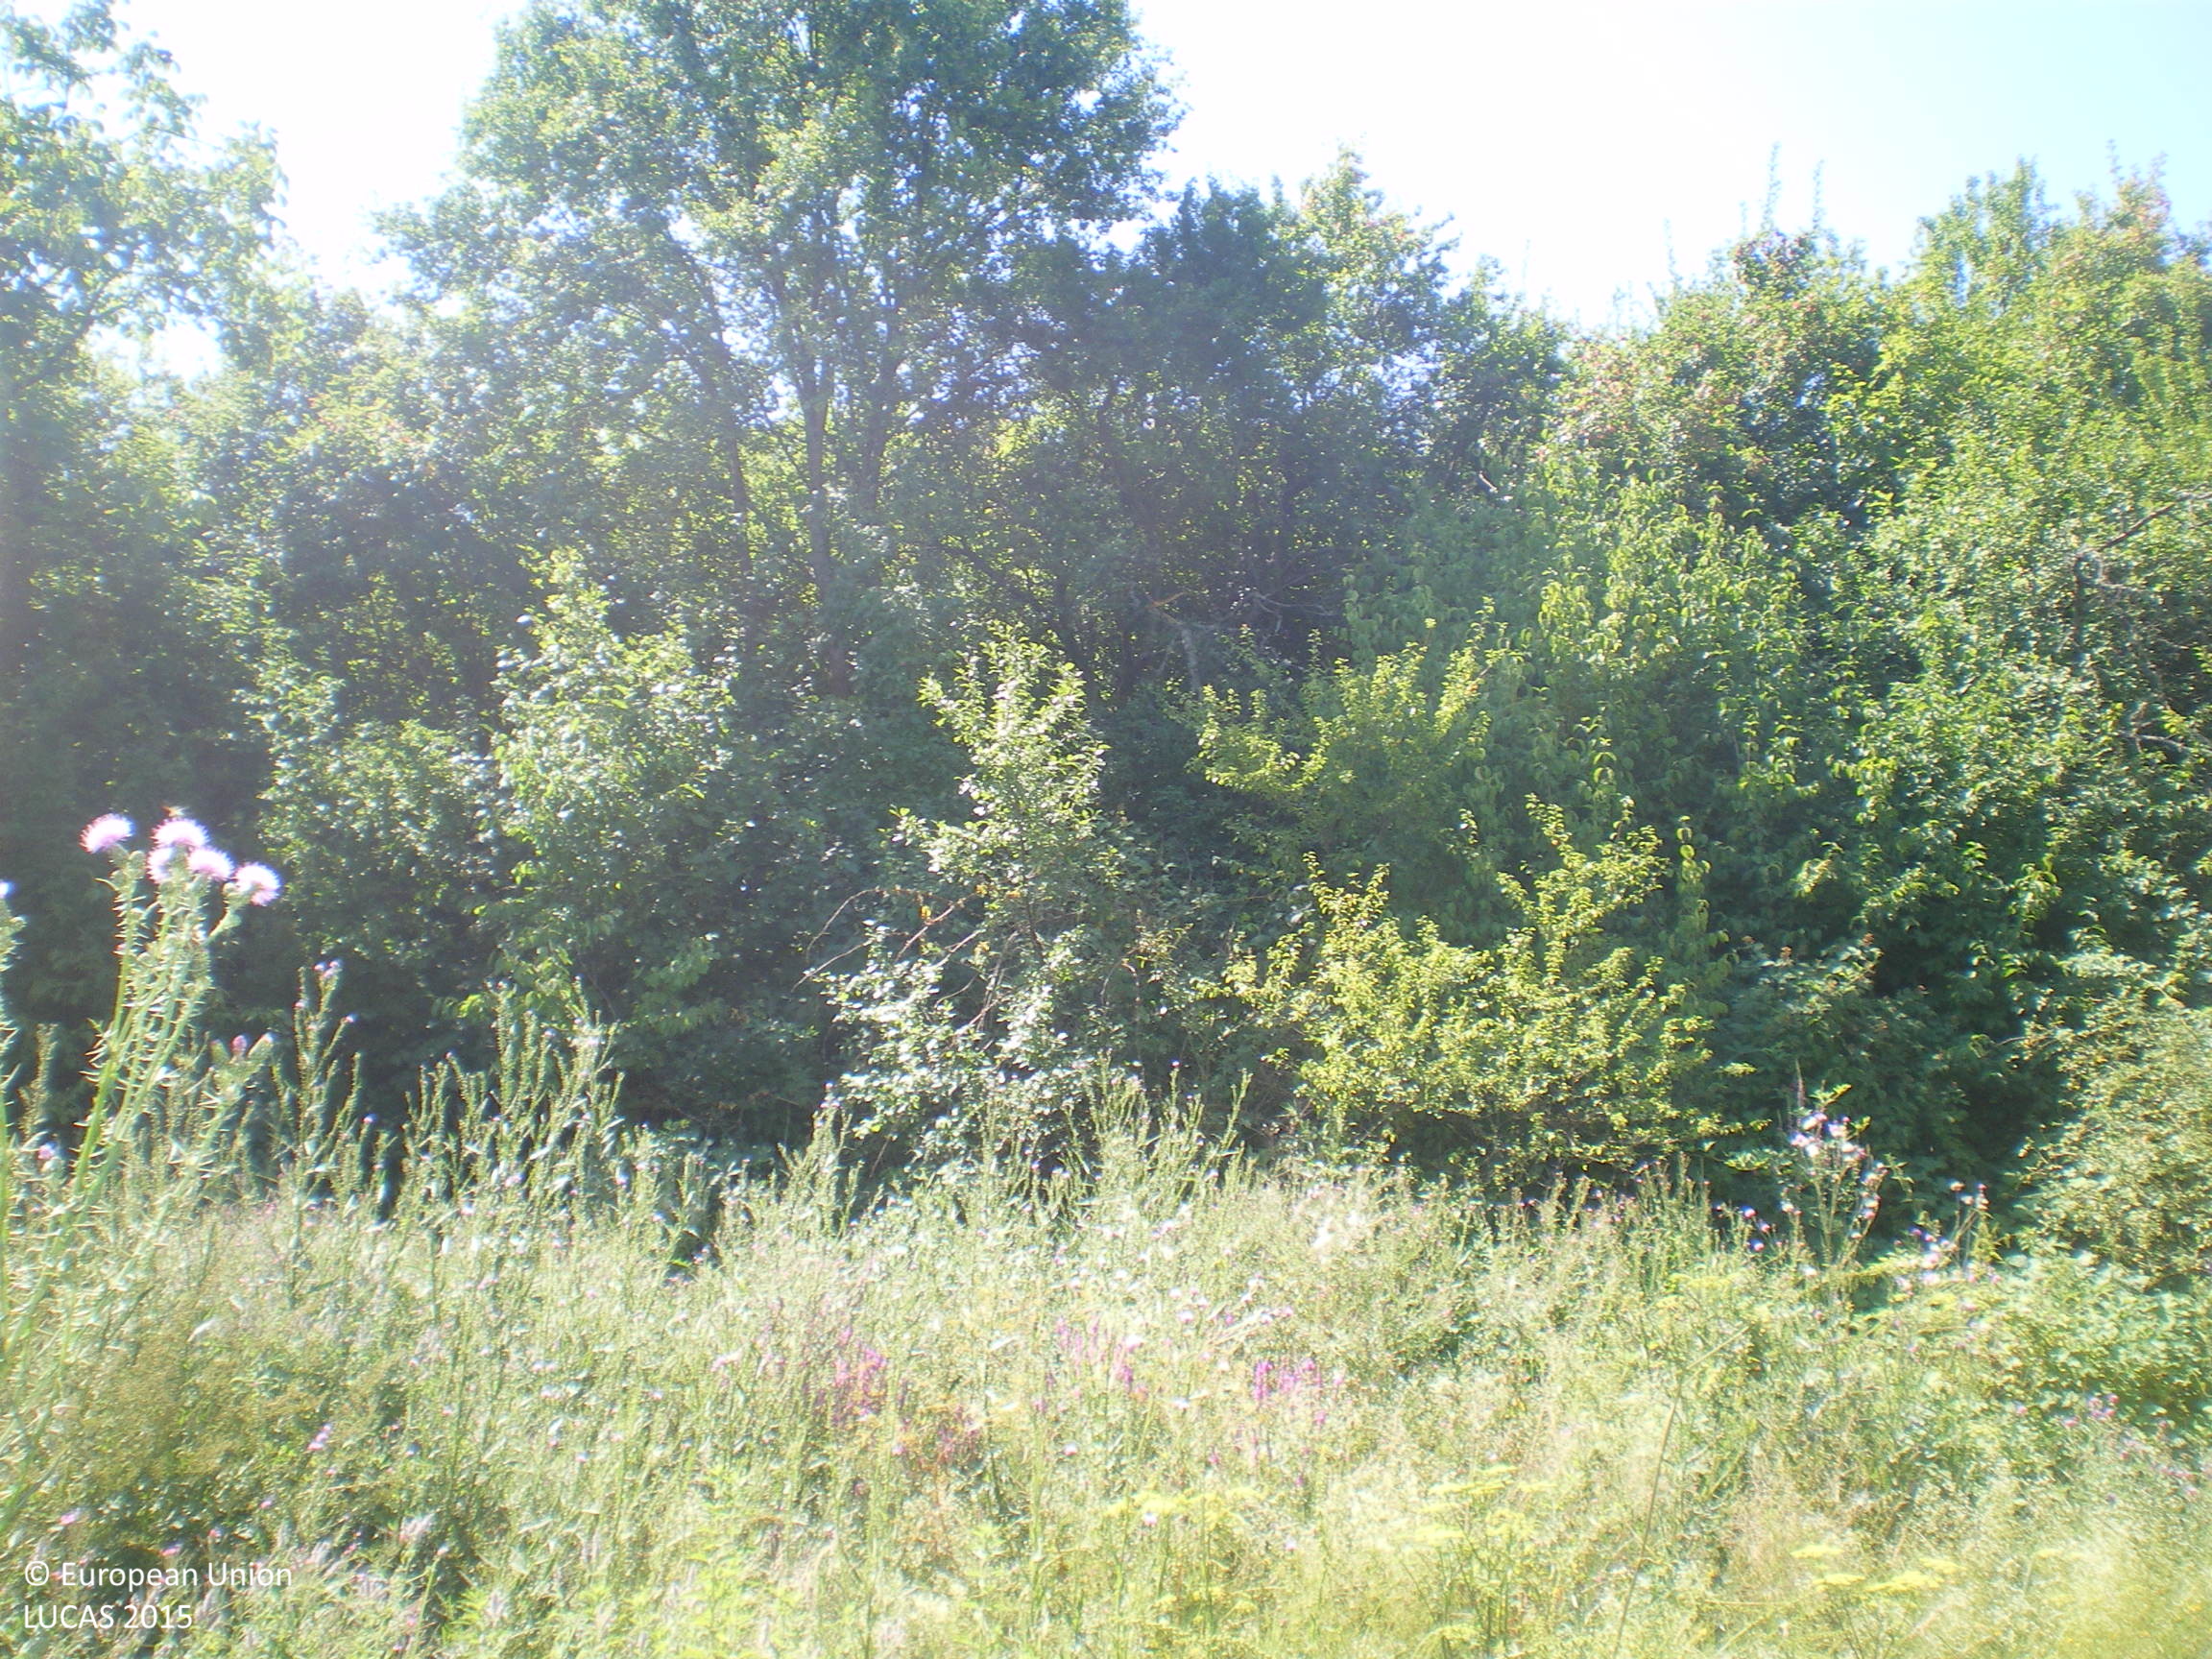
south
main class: Grassland
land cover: Spontaneously vegetated surfaces
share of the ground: > 75 %
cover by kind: herbaceous plants 100 %
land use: Semi-natural and natural areas not in use
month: July
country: BG
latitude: 42.5943
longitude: 25.1143
